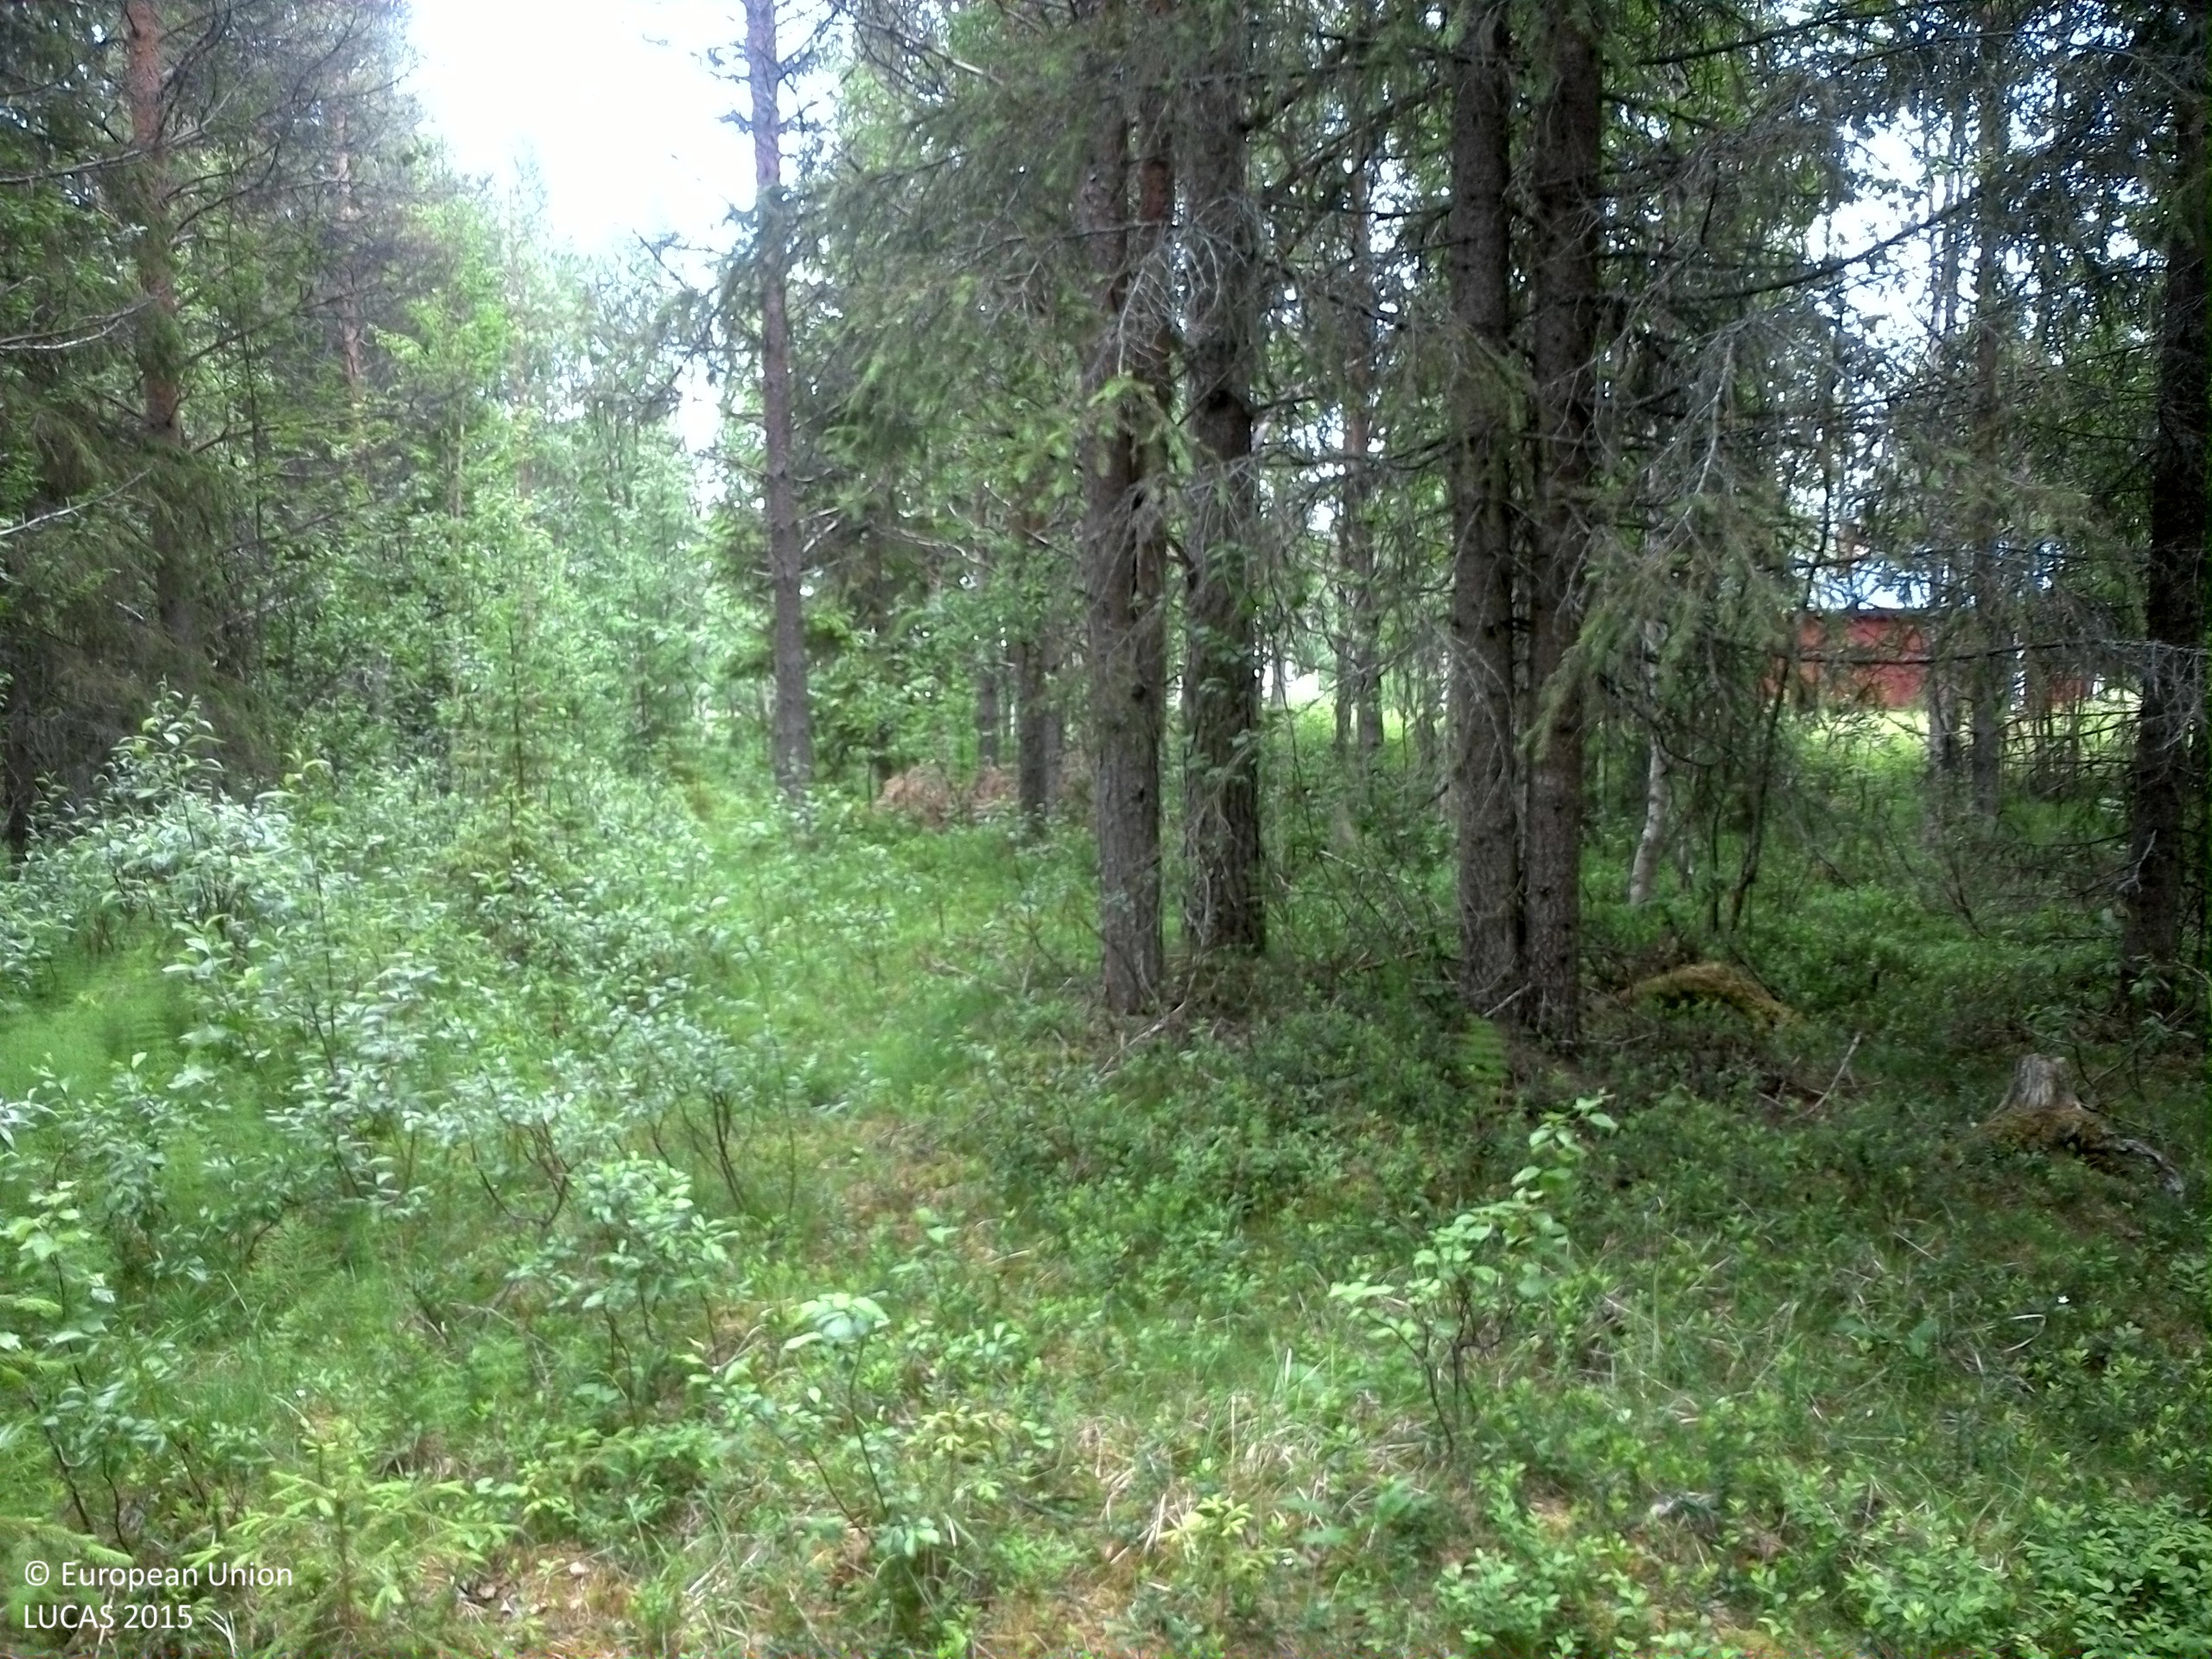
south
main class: Woodland
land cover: Other mixed woodland
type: boreal forest
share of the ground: 50 - 75 %
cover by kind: coniferous forest trees 45 %, shrubs 25 %, broadleaved forest trees 15 %, lichens and mosses 10 %, herbaceous plants 5 %
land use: Forestry
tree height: > 5 m
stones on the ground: 10 - 25 %
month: July
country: SE
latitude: 64.4096
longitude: 16.0490
